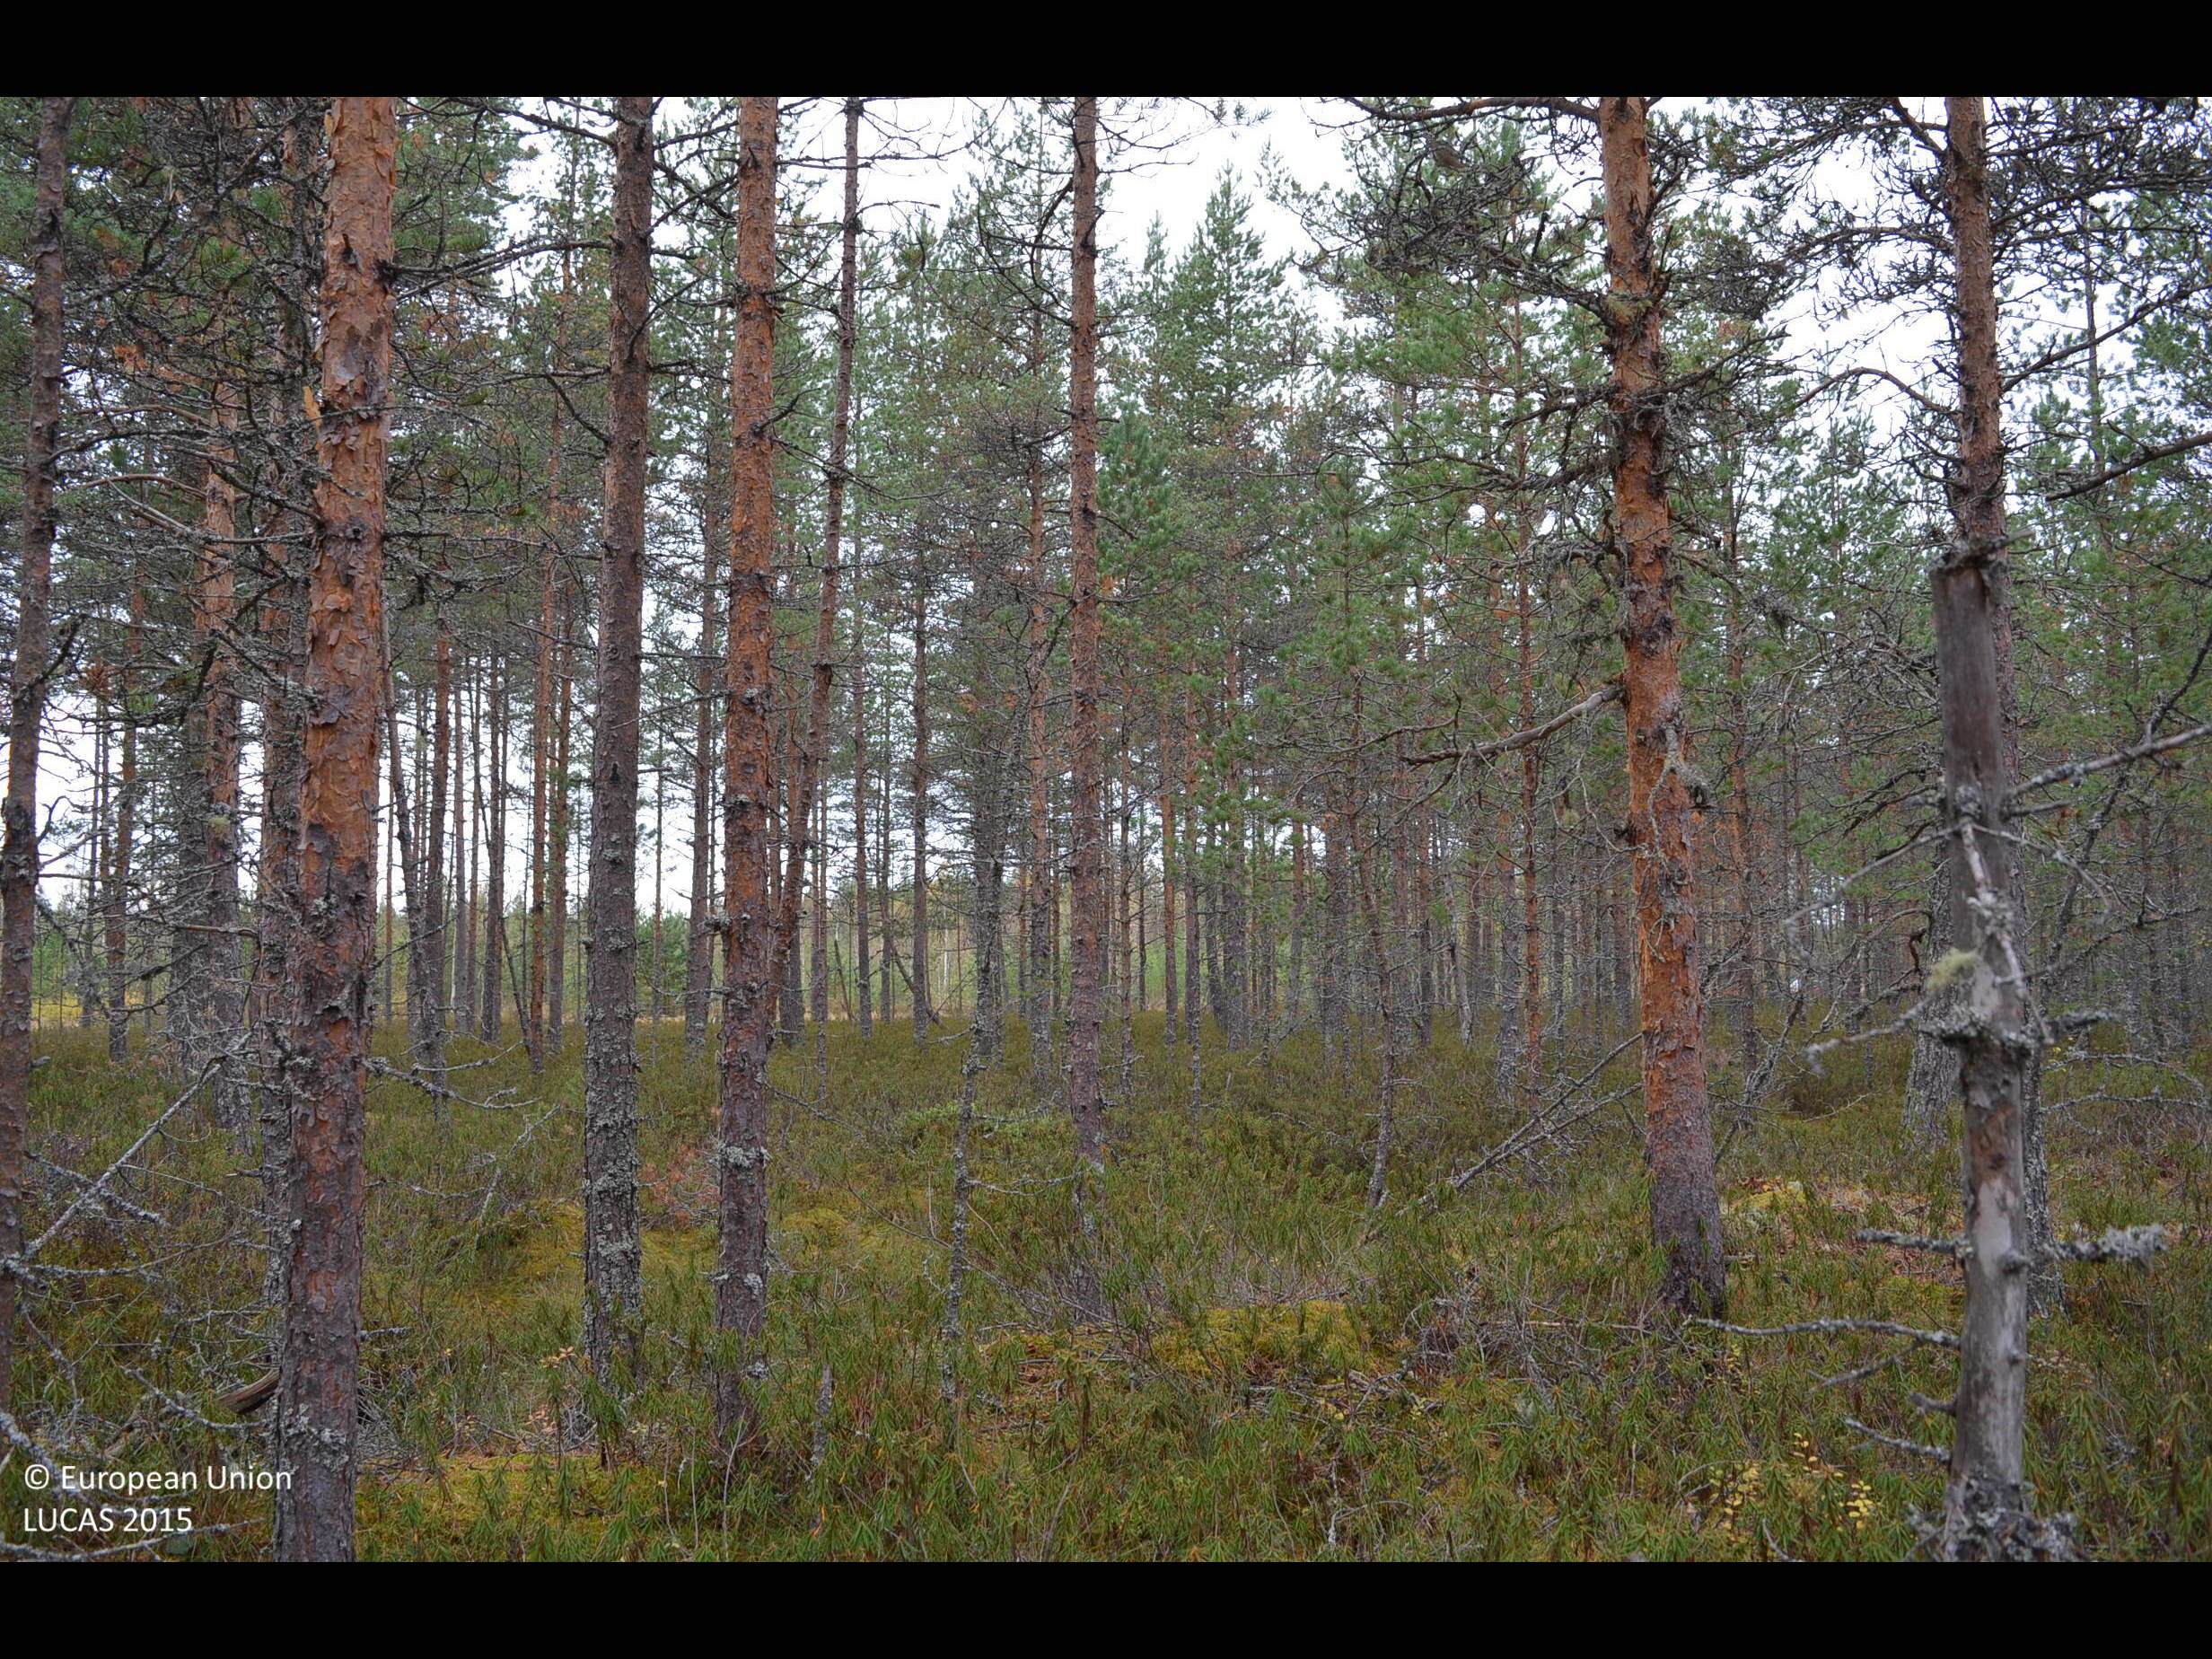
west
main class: Woodland
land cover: Pine dominated coniferous woodland
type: mire and swamp forests
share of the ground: 50 - 75 %
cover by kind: coniferous forest trees 65 %, shrubs 25 %, herbaceous plants 5 %, lichens and mosses 5 %
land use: Forestry
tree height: > 5 m
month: October
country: FI
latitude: 62.3883
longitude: 23.4744
